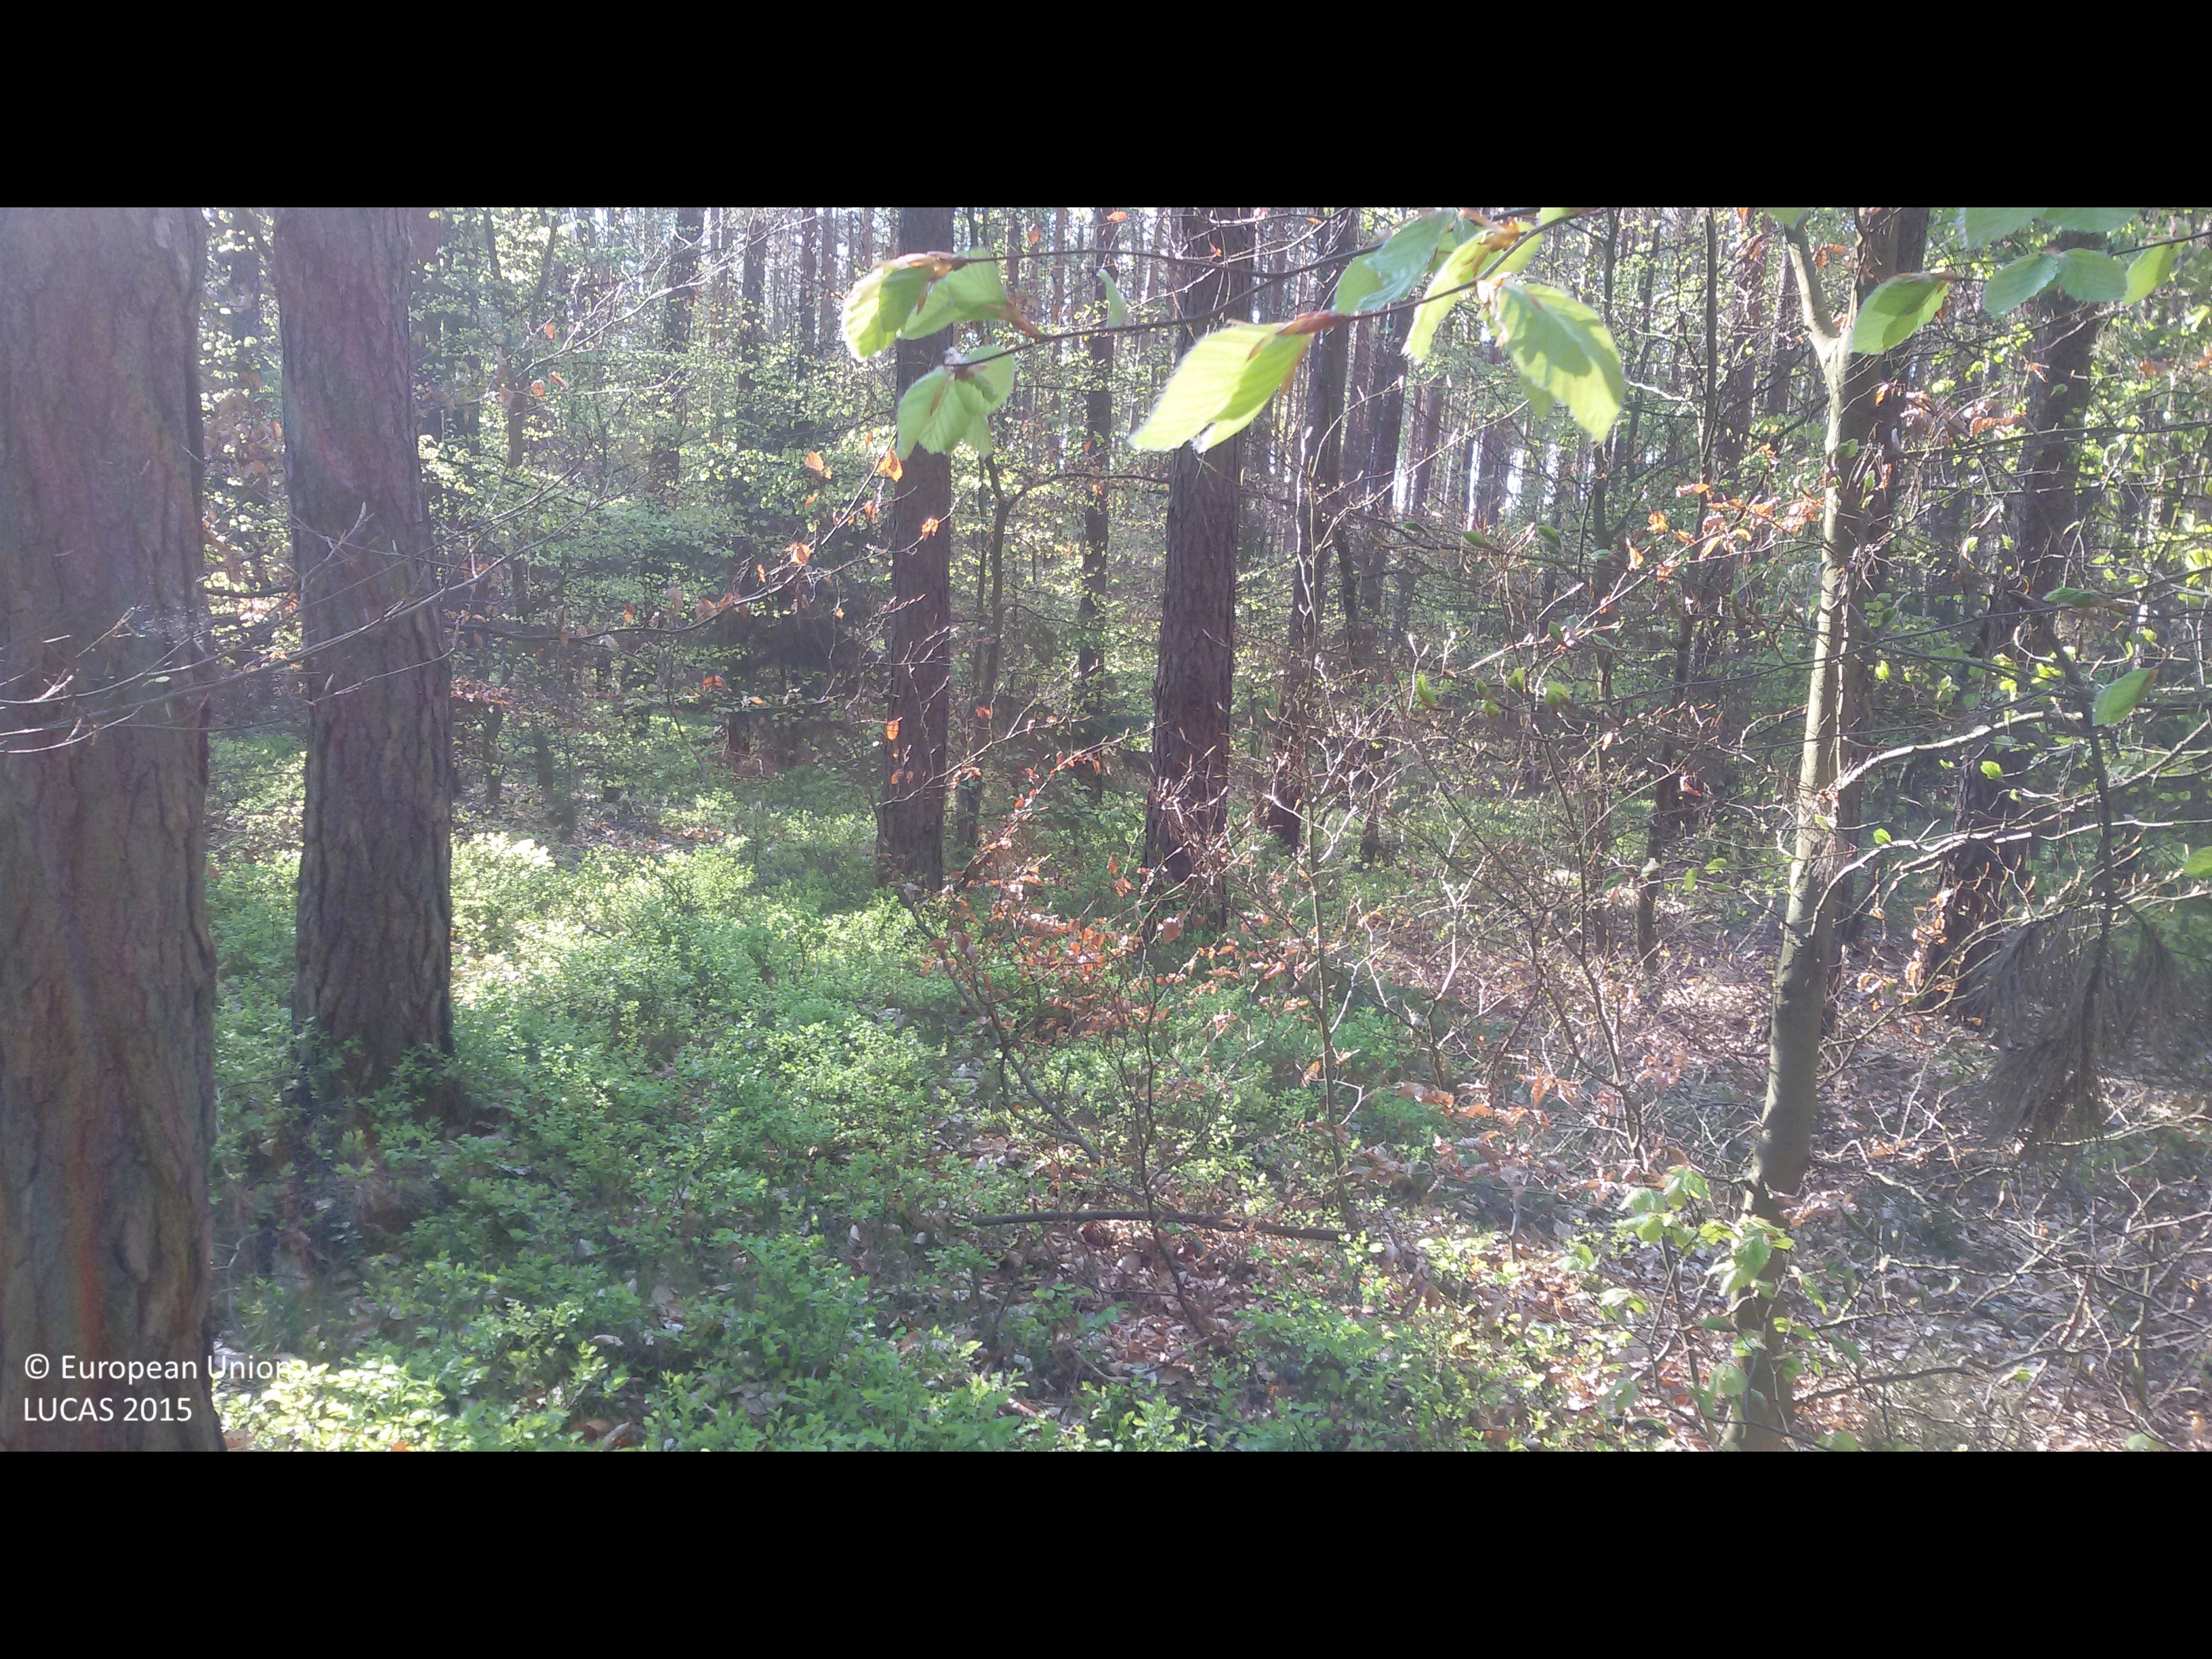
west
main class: Woodland
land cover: Pine dominated mixed woodland
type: hemiboreal forest and nemoral coniferous forest and mixed broadleaved-coniferous forest
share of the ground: > 75 %
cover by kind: coniferous forest trees 60 %, broadleaved forest trees 25 %, shrubs 10 %, herbaceous plants 5 %
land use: Forestry
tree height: > 5 m
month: May
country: PL
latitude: 52.9992
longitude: 17.0277
